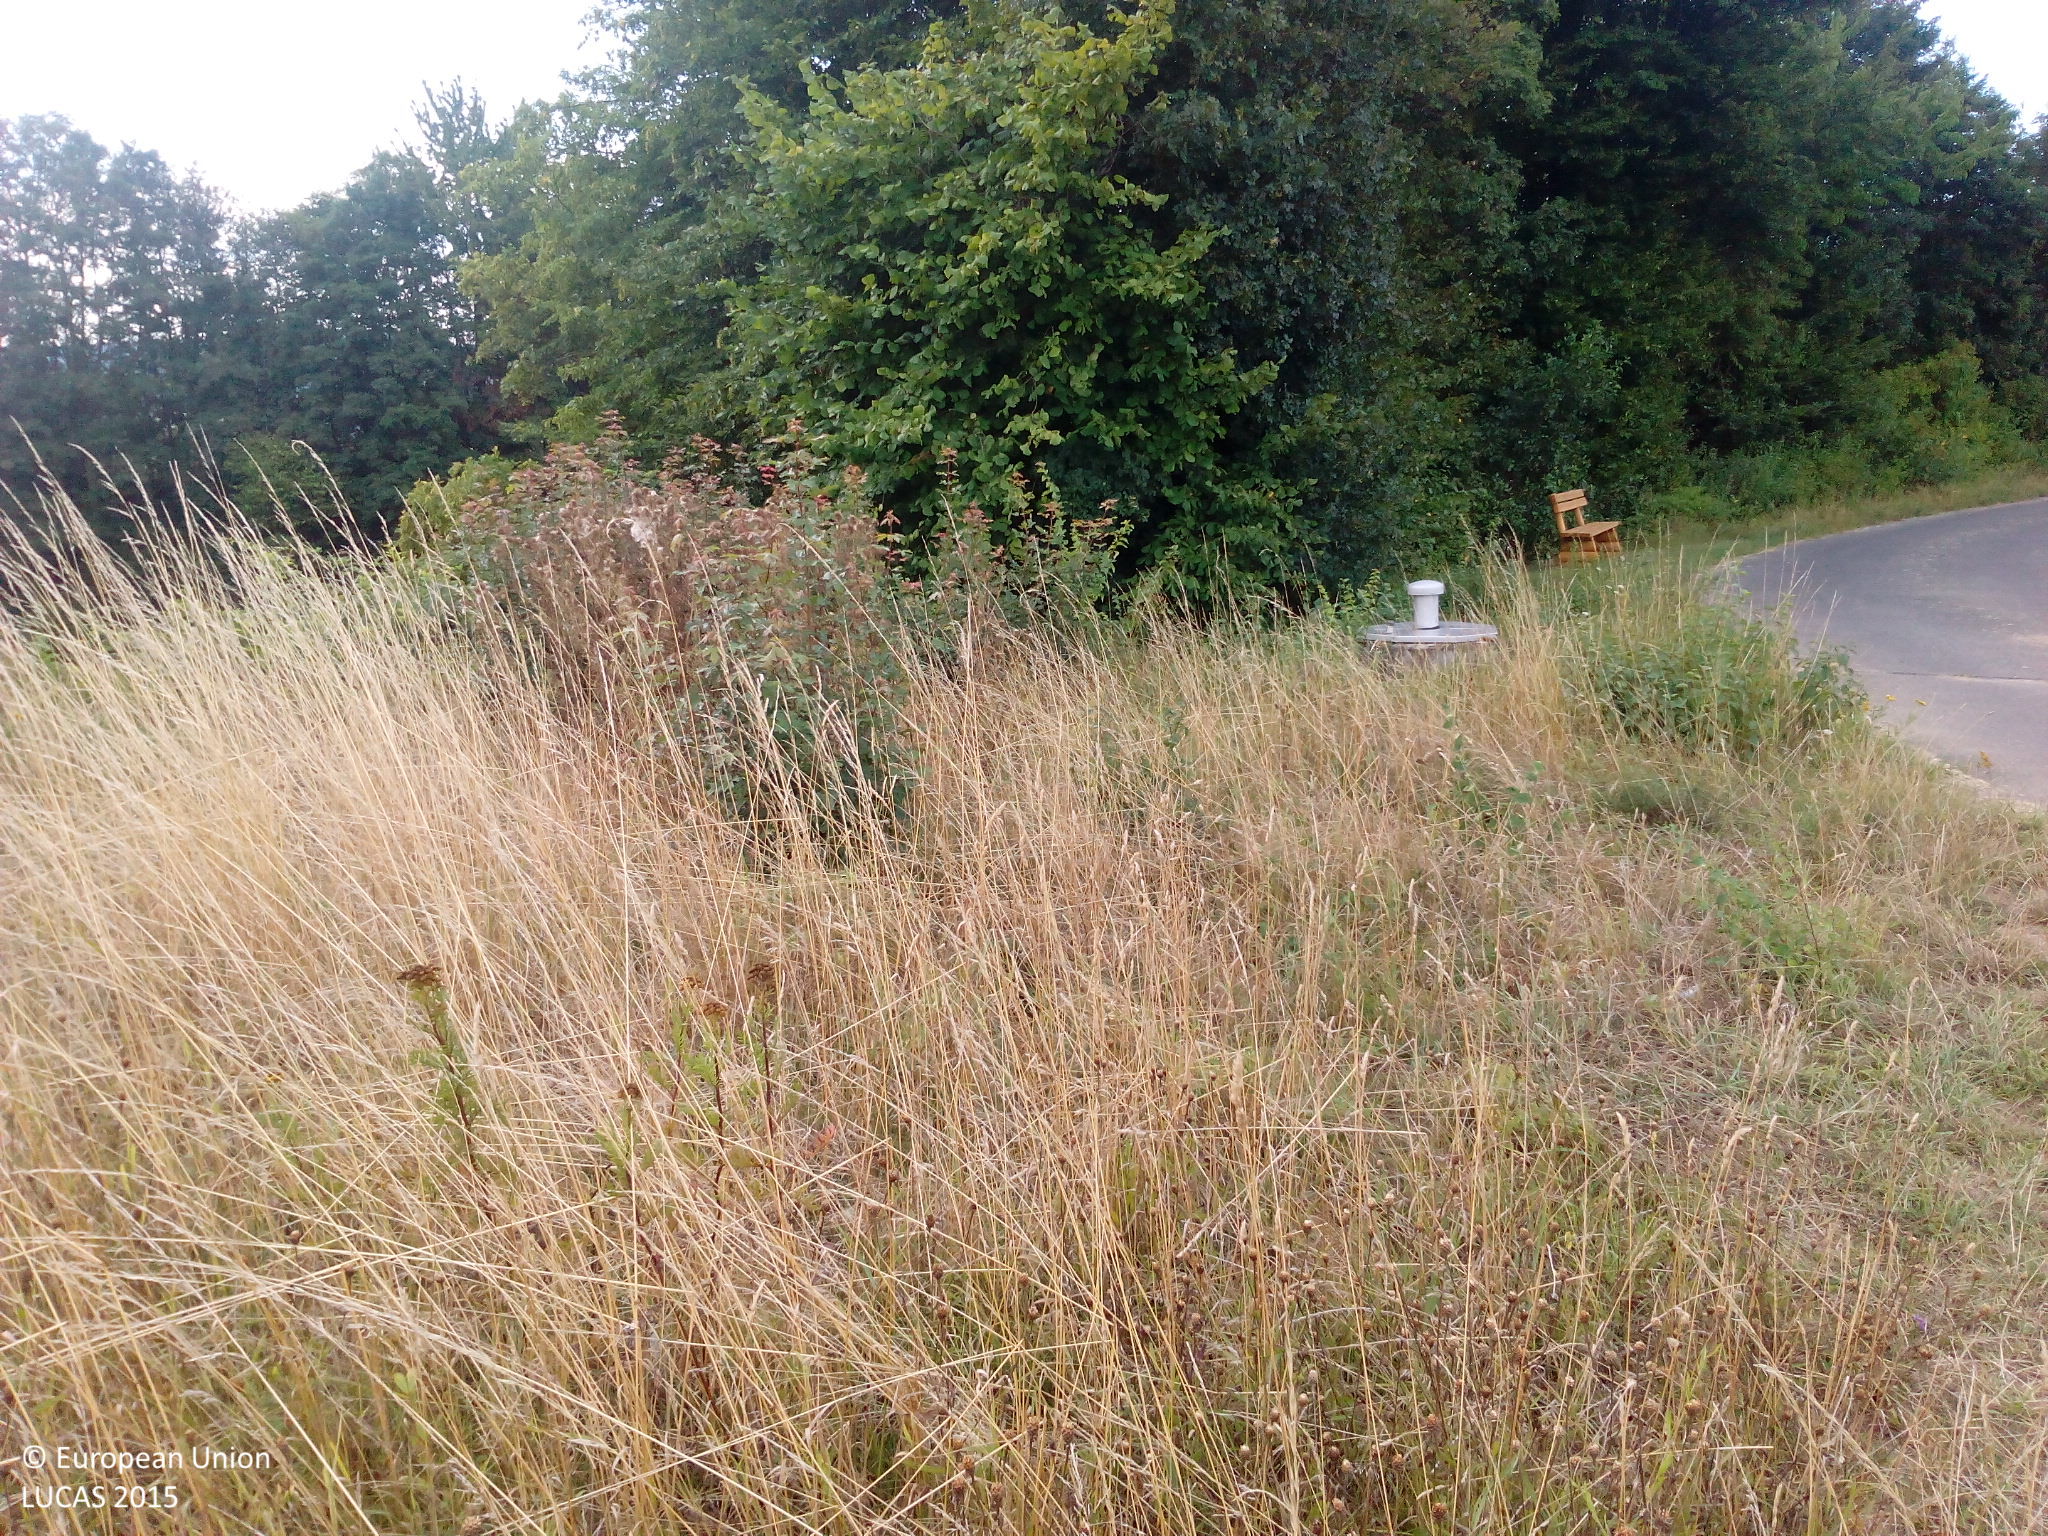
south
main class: Grassland
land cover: Grassland without tree/shrub cover
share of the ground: > 75 %
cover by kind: herbaceous plants 95 %, unconsolidated bare surface 5 %
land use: Road transport
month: August
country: DE
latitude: 50.3005
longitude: 7.4873
